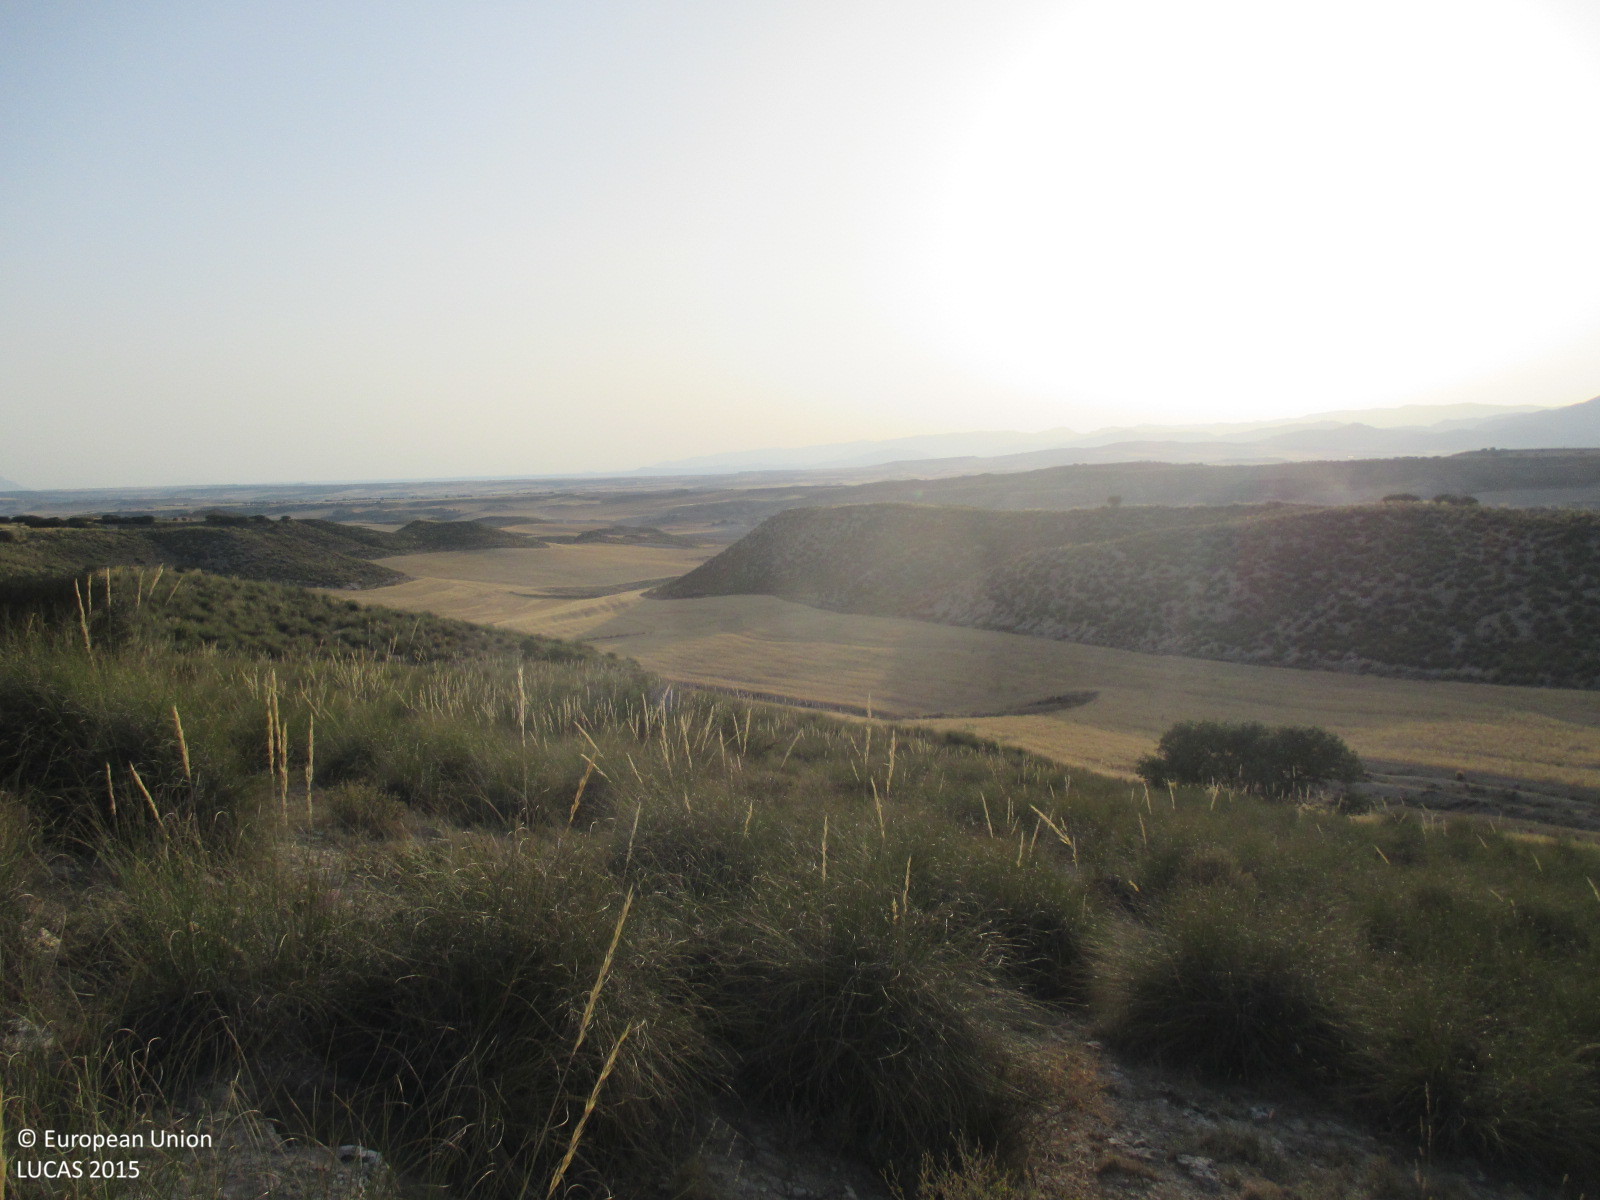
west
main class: Grassland
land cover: Grassland without tree/shrub cover
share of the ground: > 75 %
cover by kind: herbaceous plants 90 %, consolidated bare surface 5 %, unconsolidated bare surface 5 %
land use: Semi-natural and natural areas not in use
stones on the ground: < 10 %
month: June
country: ES
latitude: 37.7787
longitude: -2.3754
